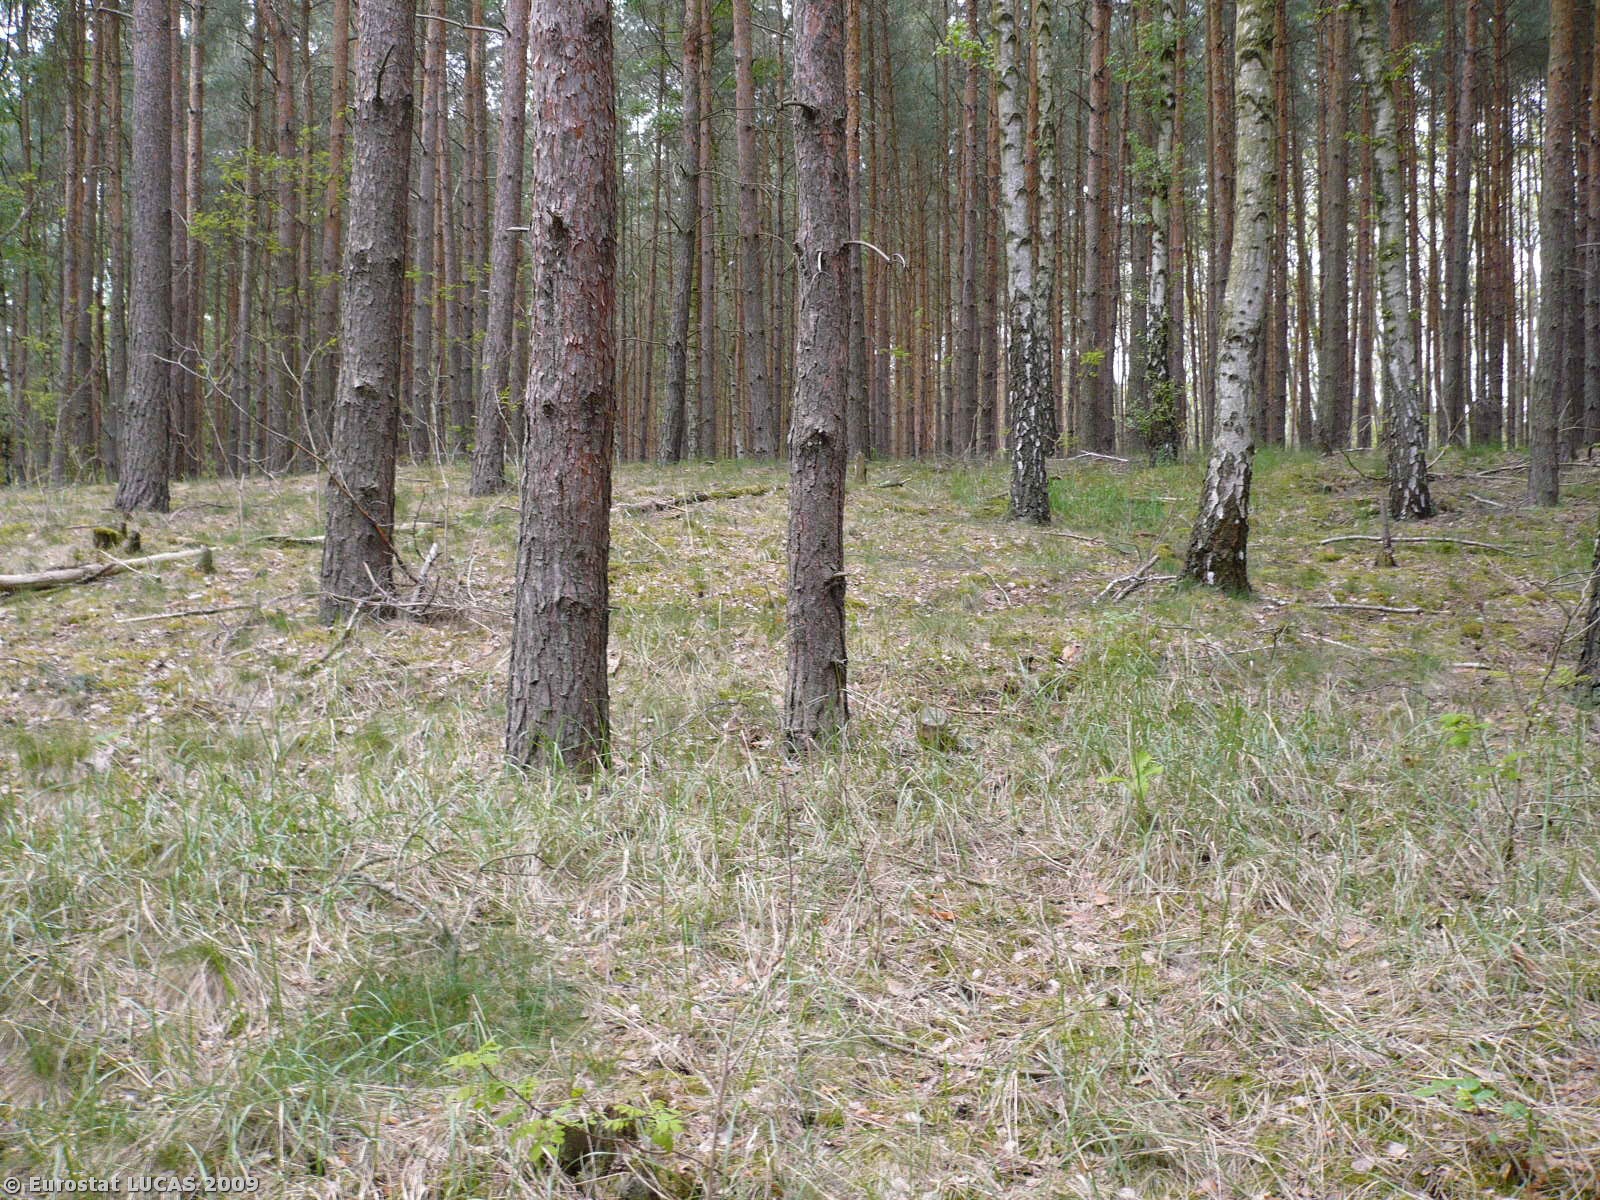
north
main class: Woodland
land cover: Coniferous woodland
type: hemiboreal forest and nemoral coniferous forest and mixed broadleaved-coniferous forest
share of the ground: > 75 %
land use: Forestry
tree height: > 5 m
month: May
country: PL
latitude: 52.0614
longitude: 15.6785
